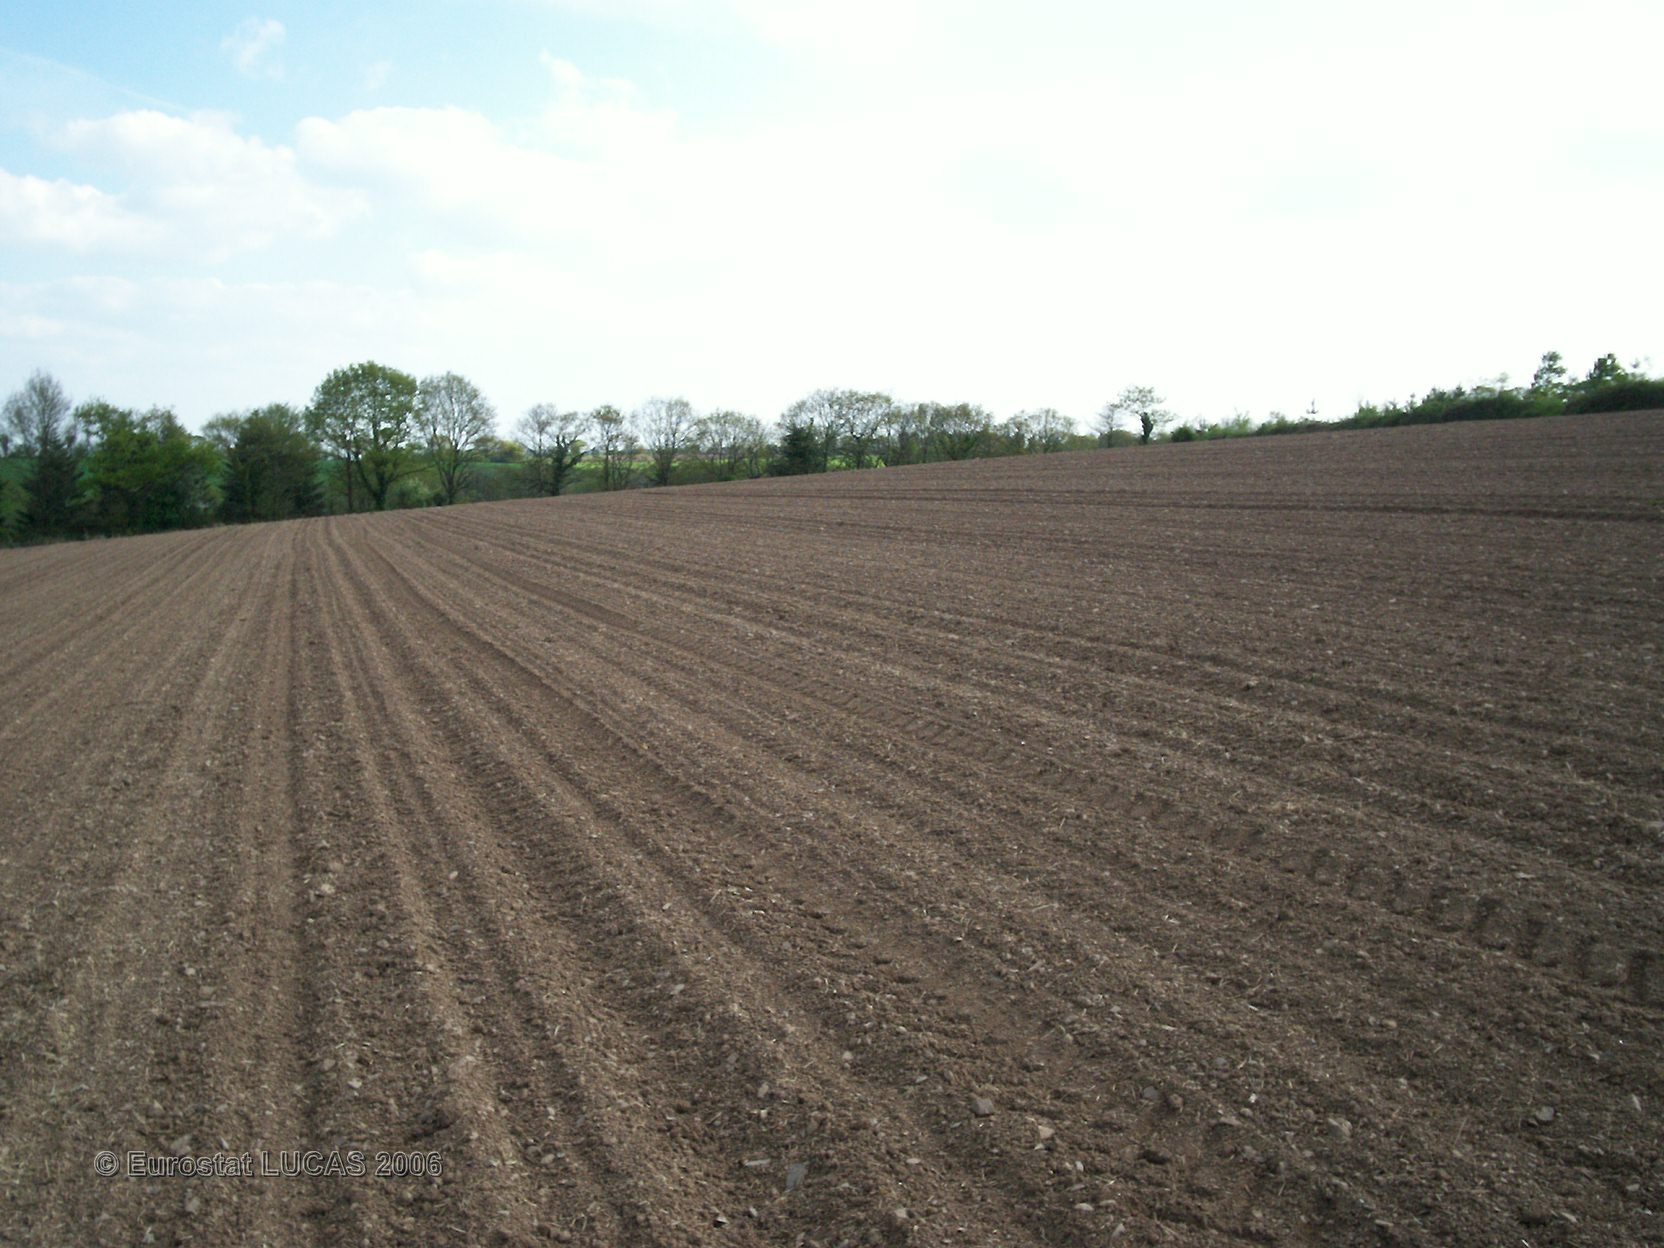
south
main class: Bare land
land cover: Bare land
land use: Agriculture (excluding fallow land and kitchen gardens)
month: May
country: FR
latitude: 48.3766
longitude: -3.6222
